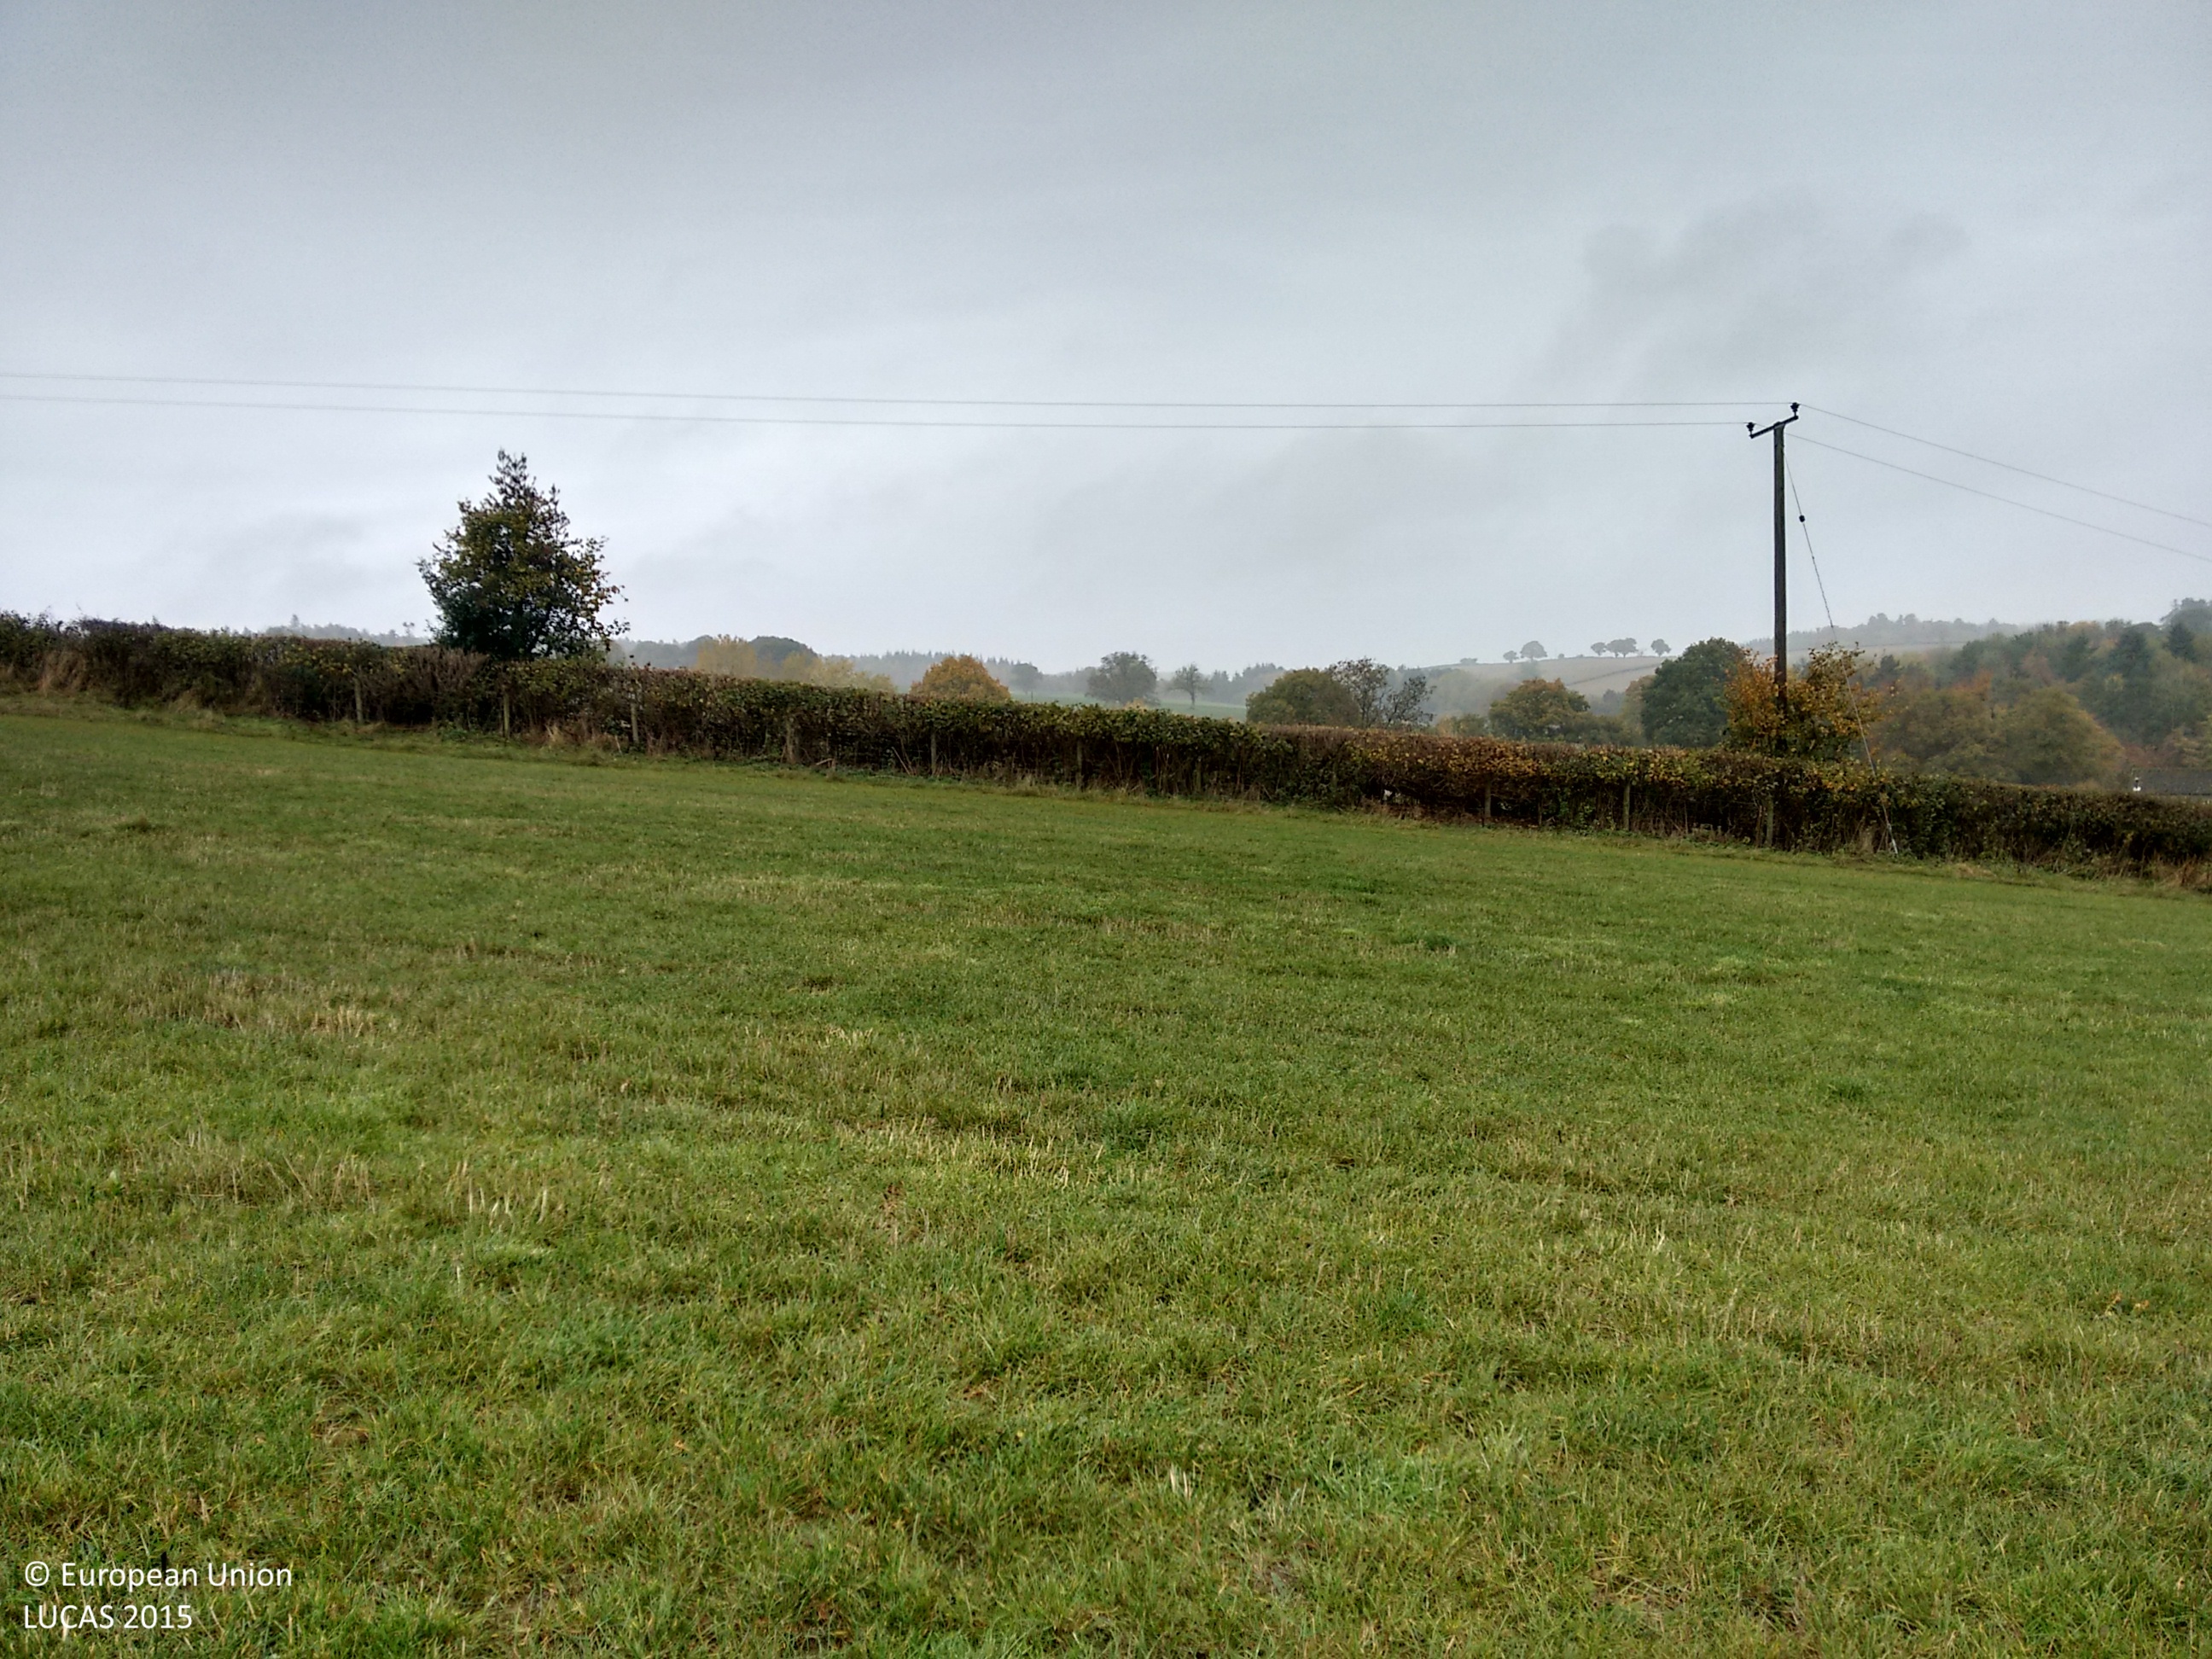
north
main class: Grassland
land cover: Grassland without tree/shrub cover
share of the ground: > 75 %
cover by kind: herbaceous plants 100 %
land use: Agriculture (excluding fallow land and kitchen gardens)
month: October
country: GB
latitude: 52.4626
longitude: -2.4734
